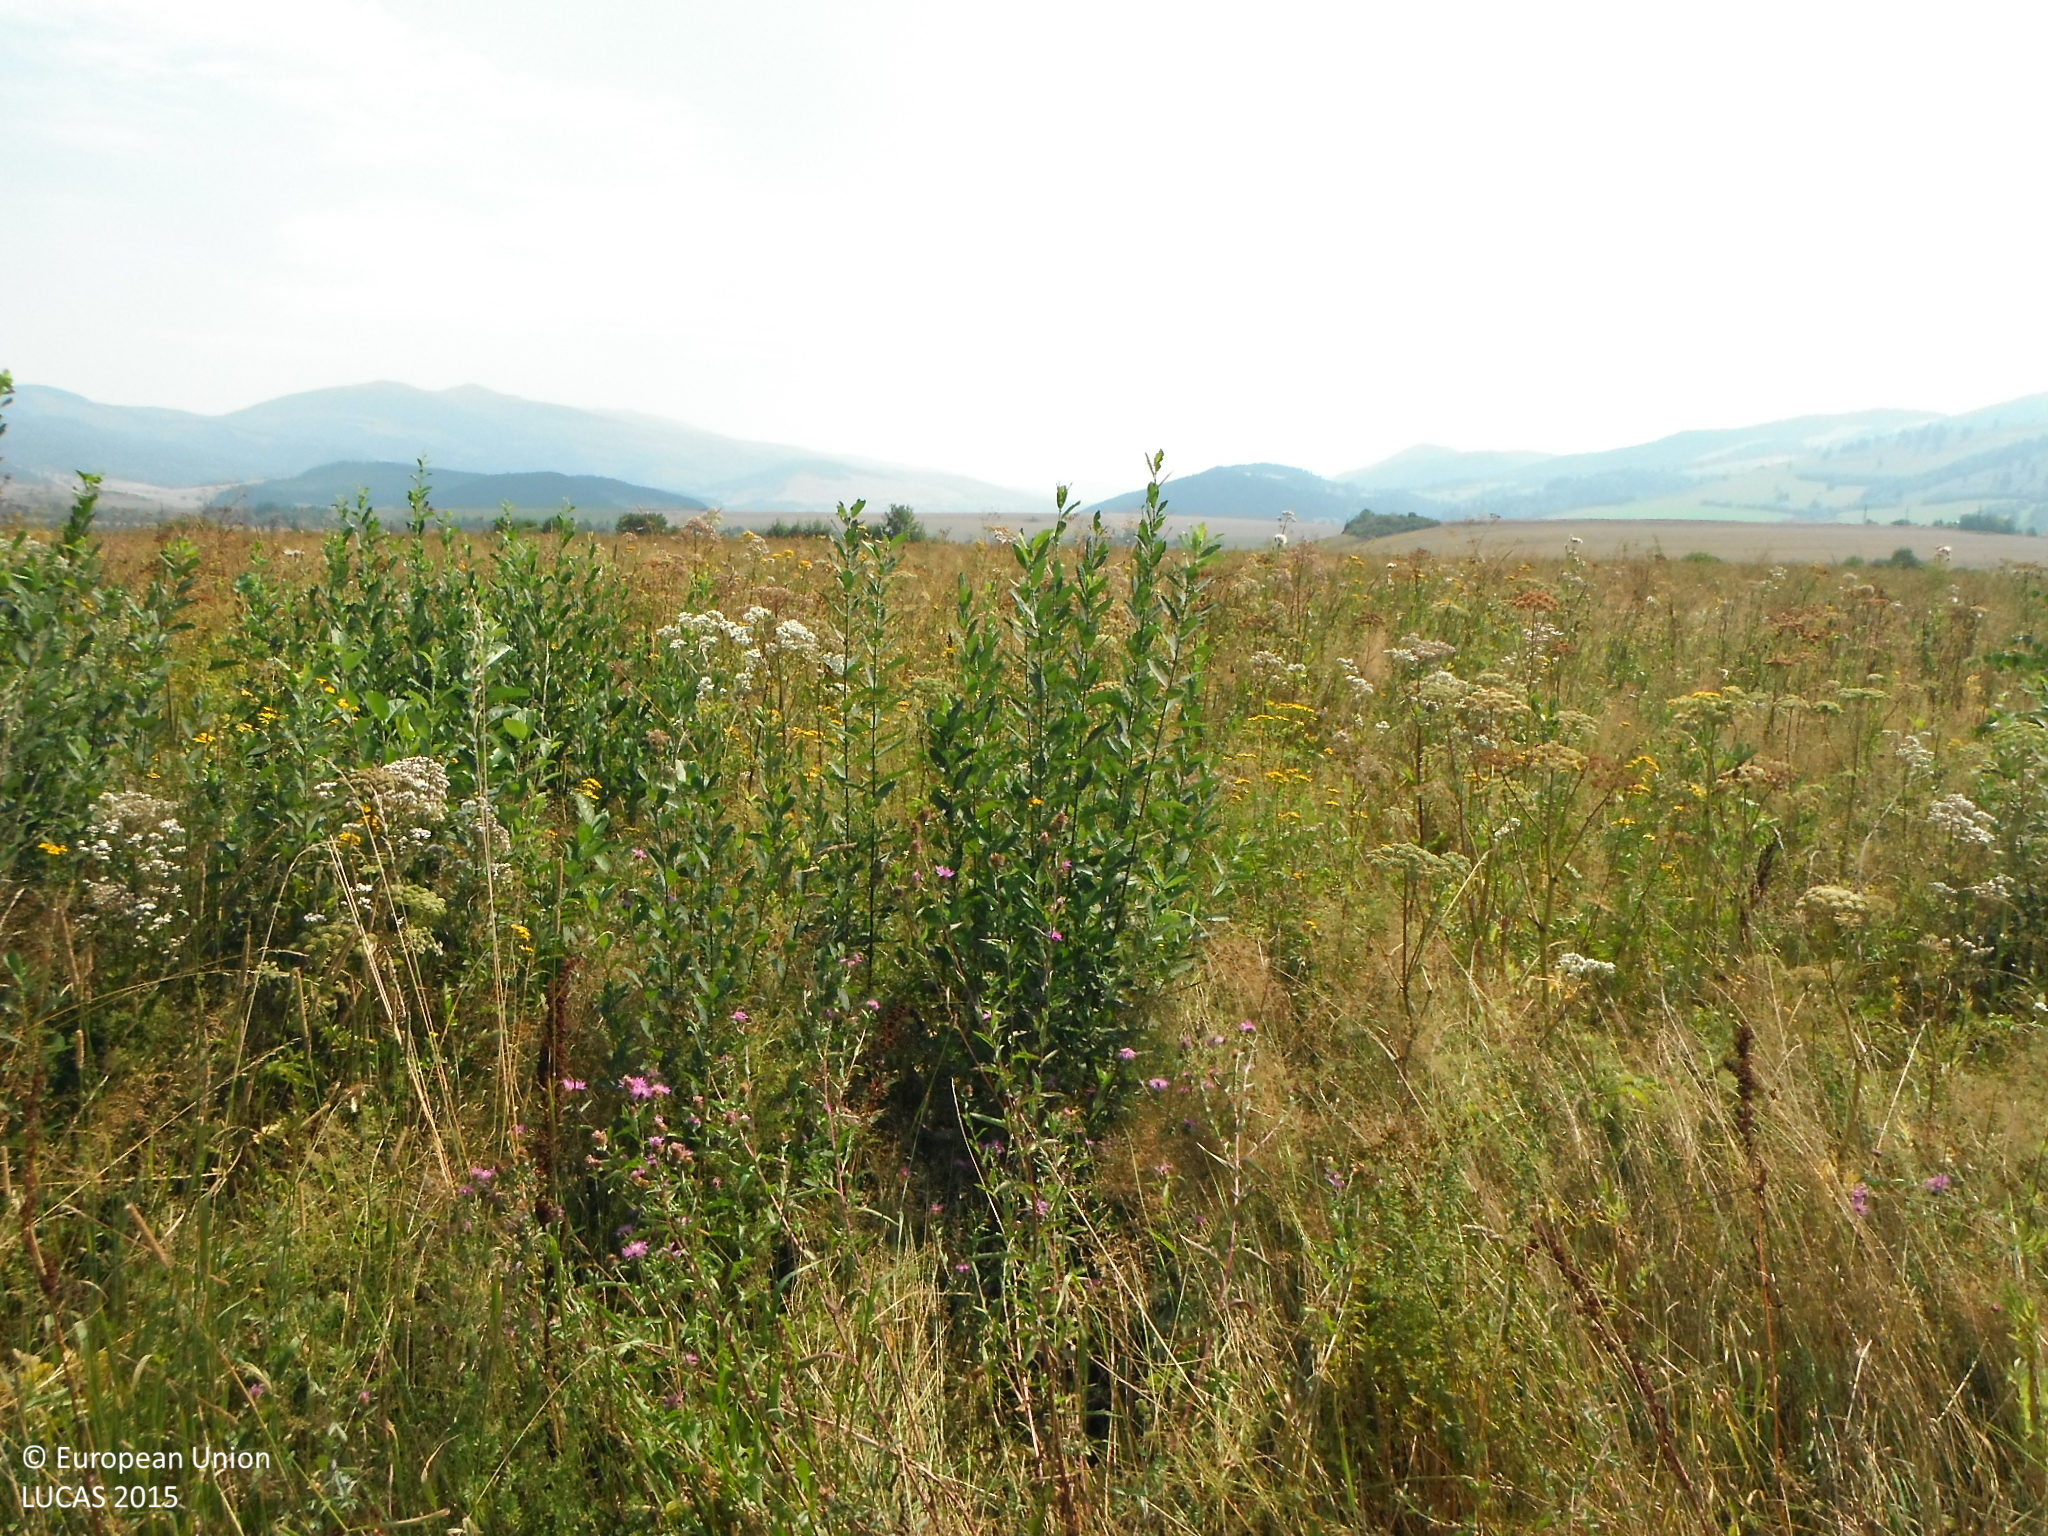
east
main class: Grassland
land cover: Grassland without tree/shrub cover
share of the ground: > 75 %
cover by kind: herbaceous plants 100 %
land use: Agriculture (excluding fallow land and kitchen gardens)
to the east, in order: Grassland without tree/shrub cover; Spontaneously vegetated surfaces; Grassland without tree/shrub cover; Electric lines; Grassland without tree/shrub cover
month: August
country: SK
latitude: 48.8633
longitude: 19.9124
